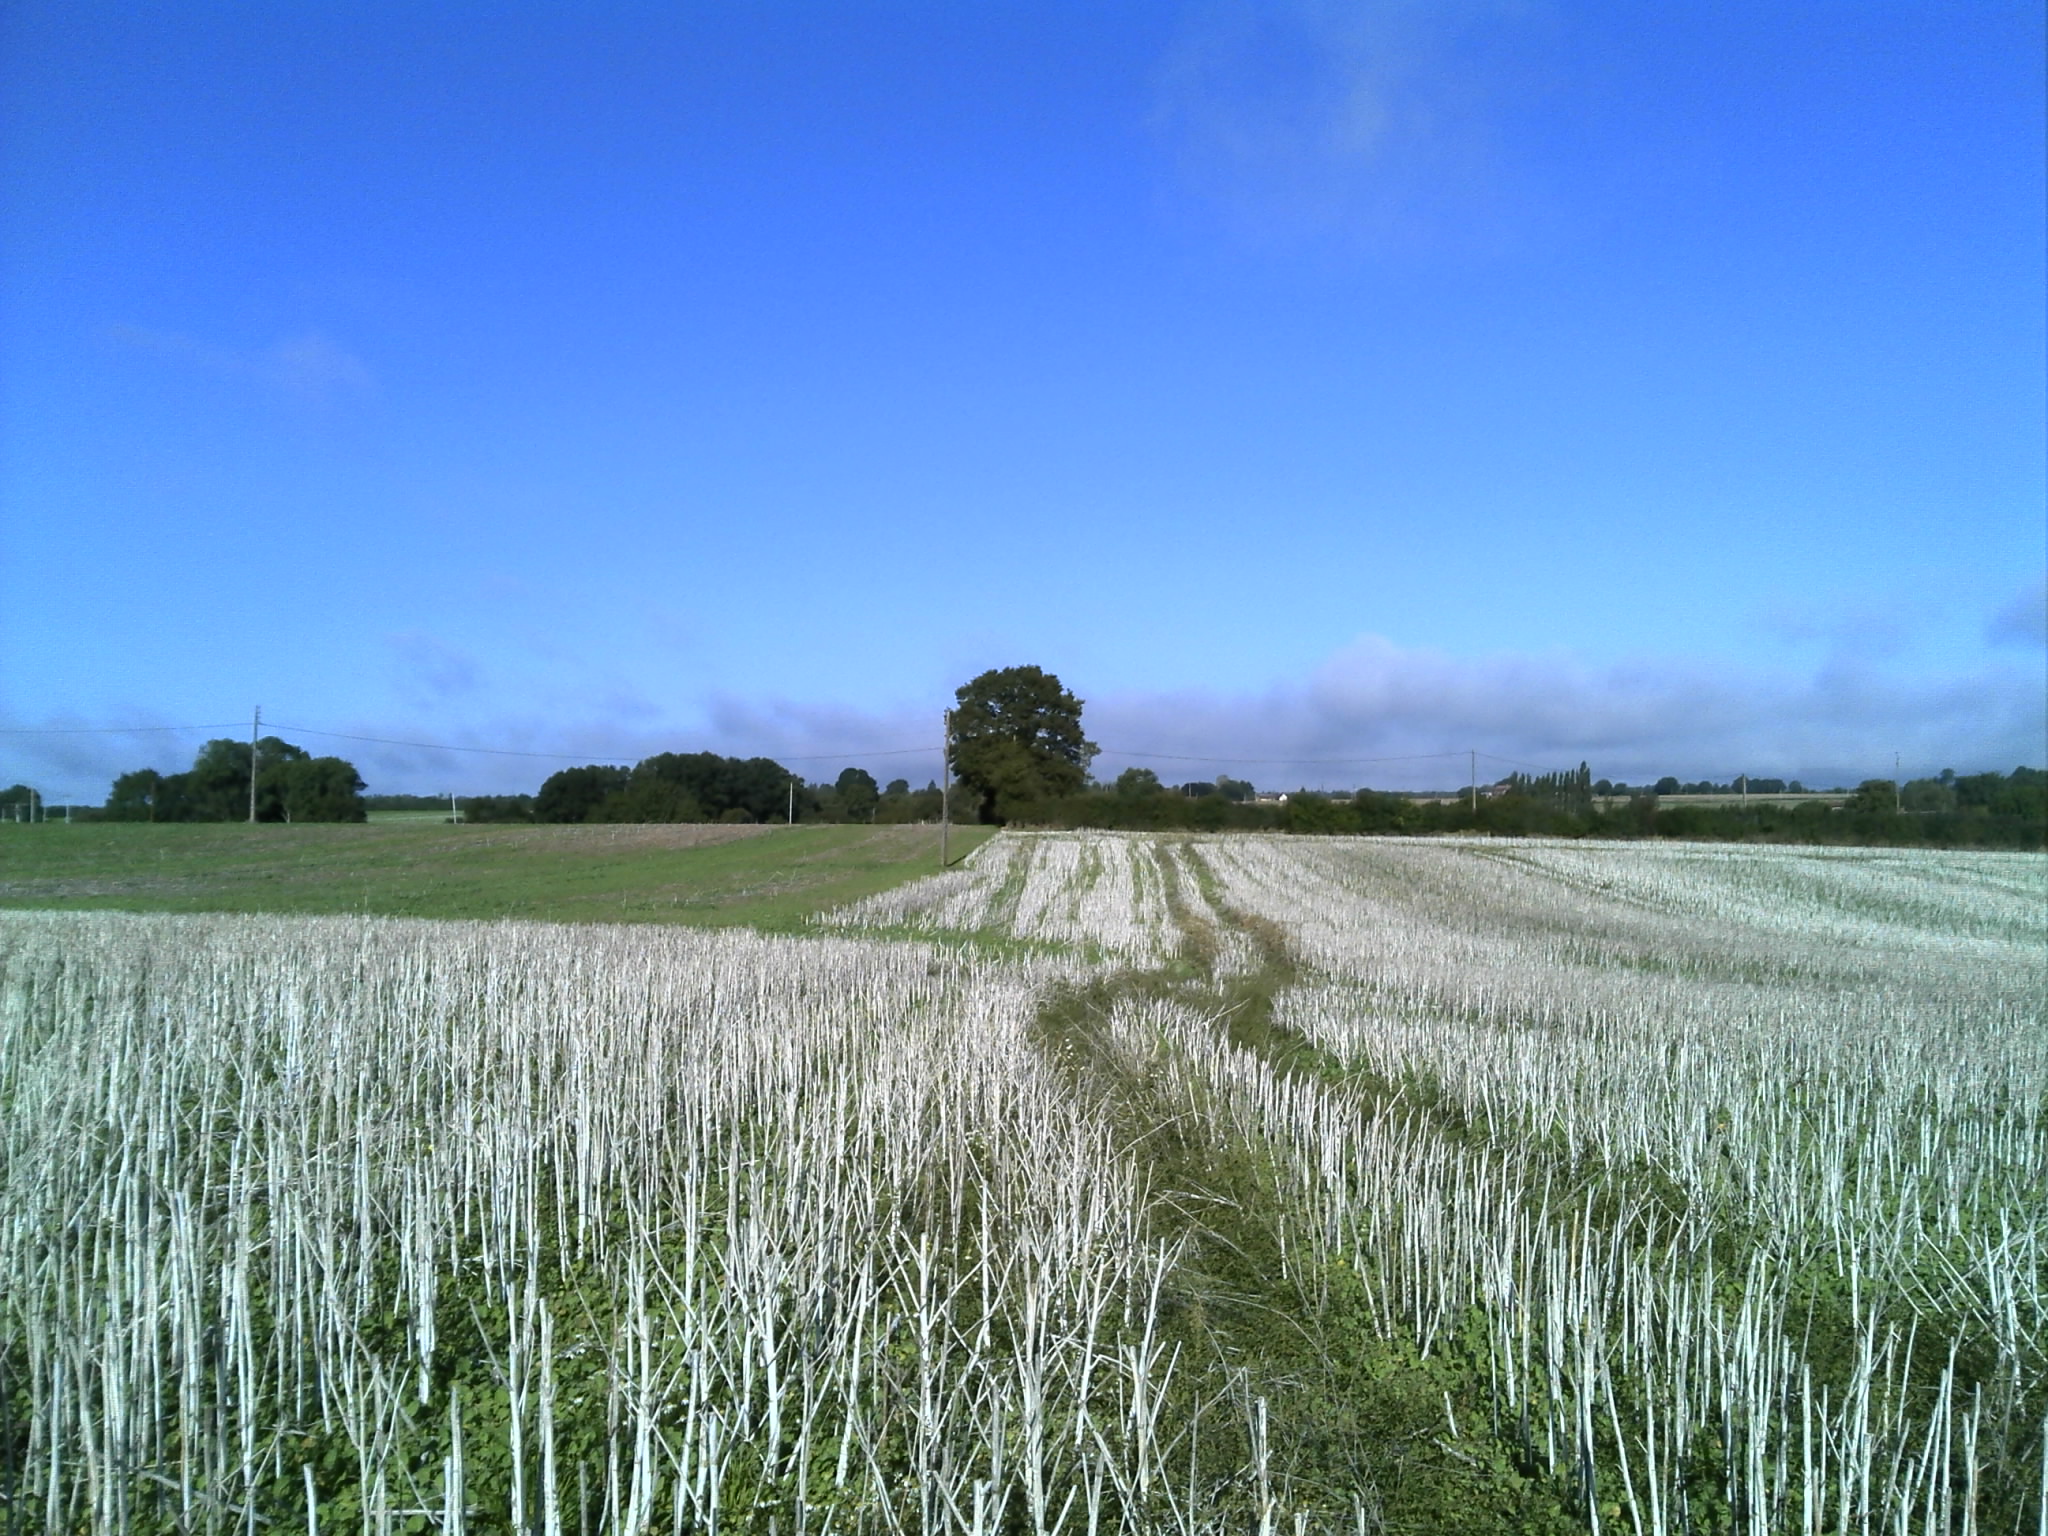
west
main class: Cropland
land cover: Rape and turnip rape
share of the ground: > 75 %
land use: Agriculture (excluding fallow land and kitchen gardens)
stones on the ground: < 10 %
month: September
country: FR
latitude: 47.9563
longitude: 0.6984
